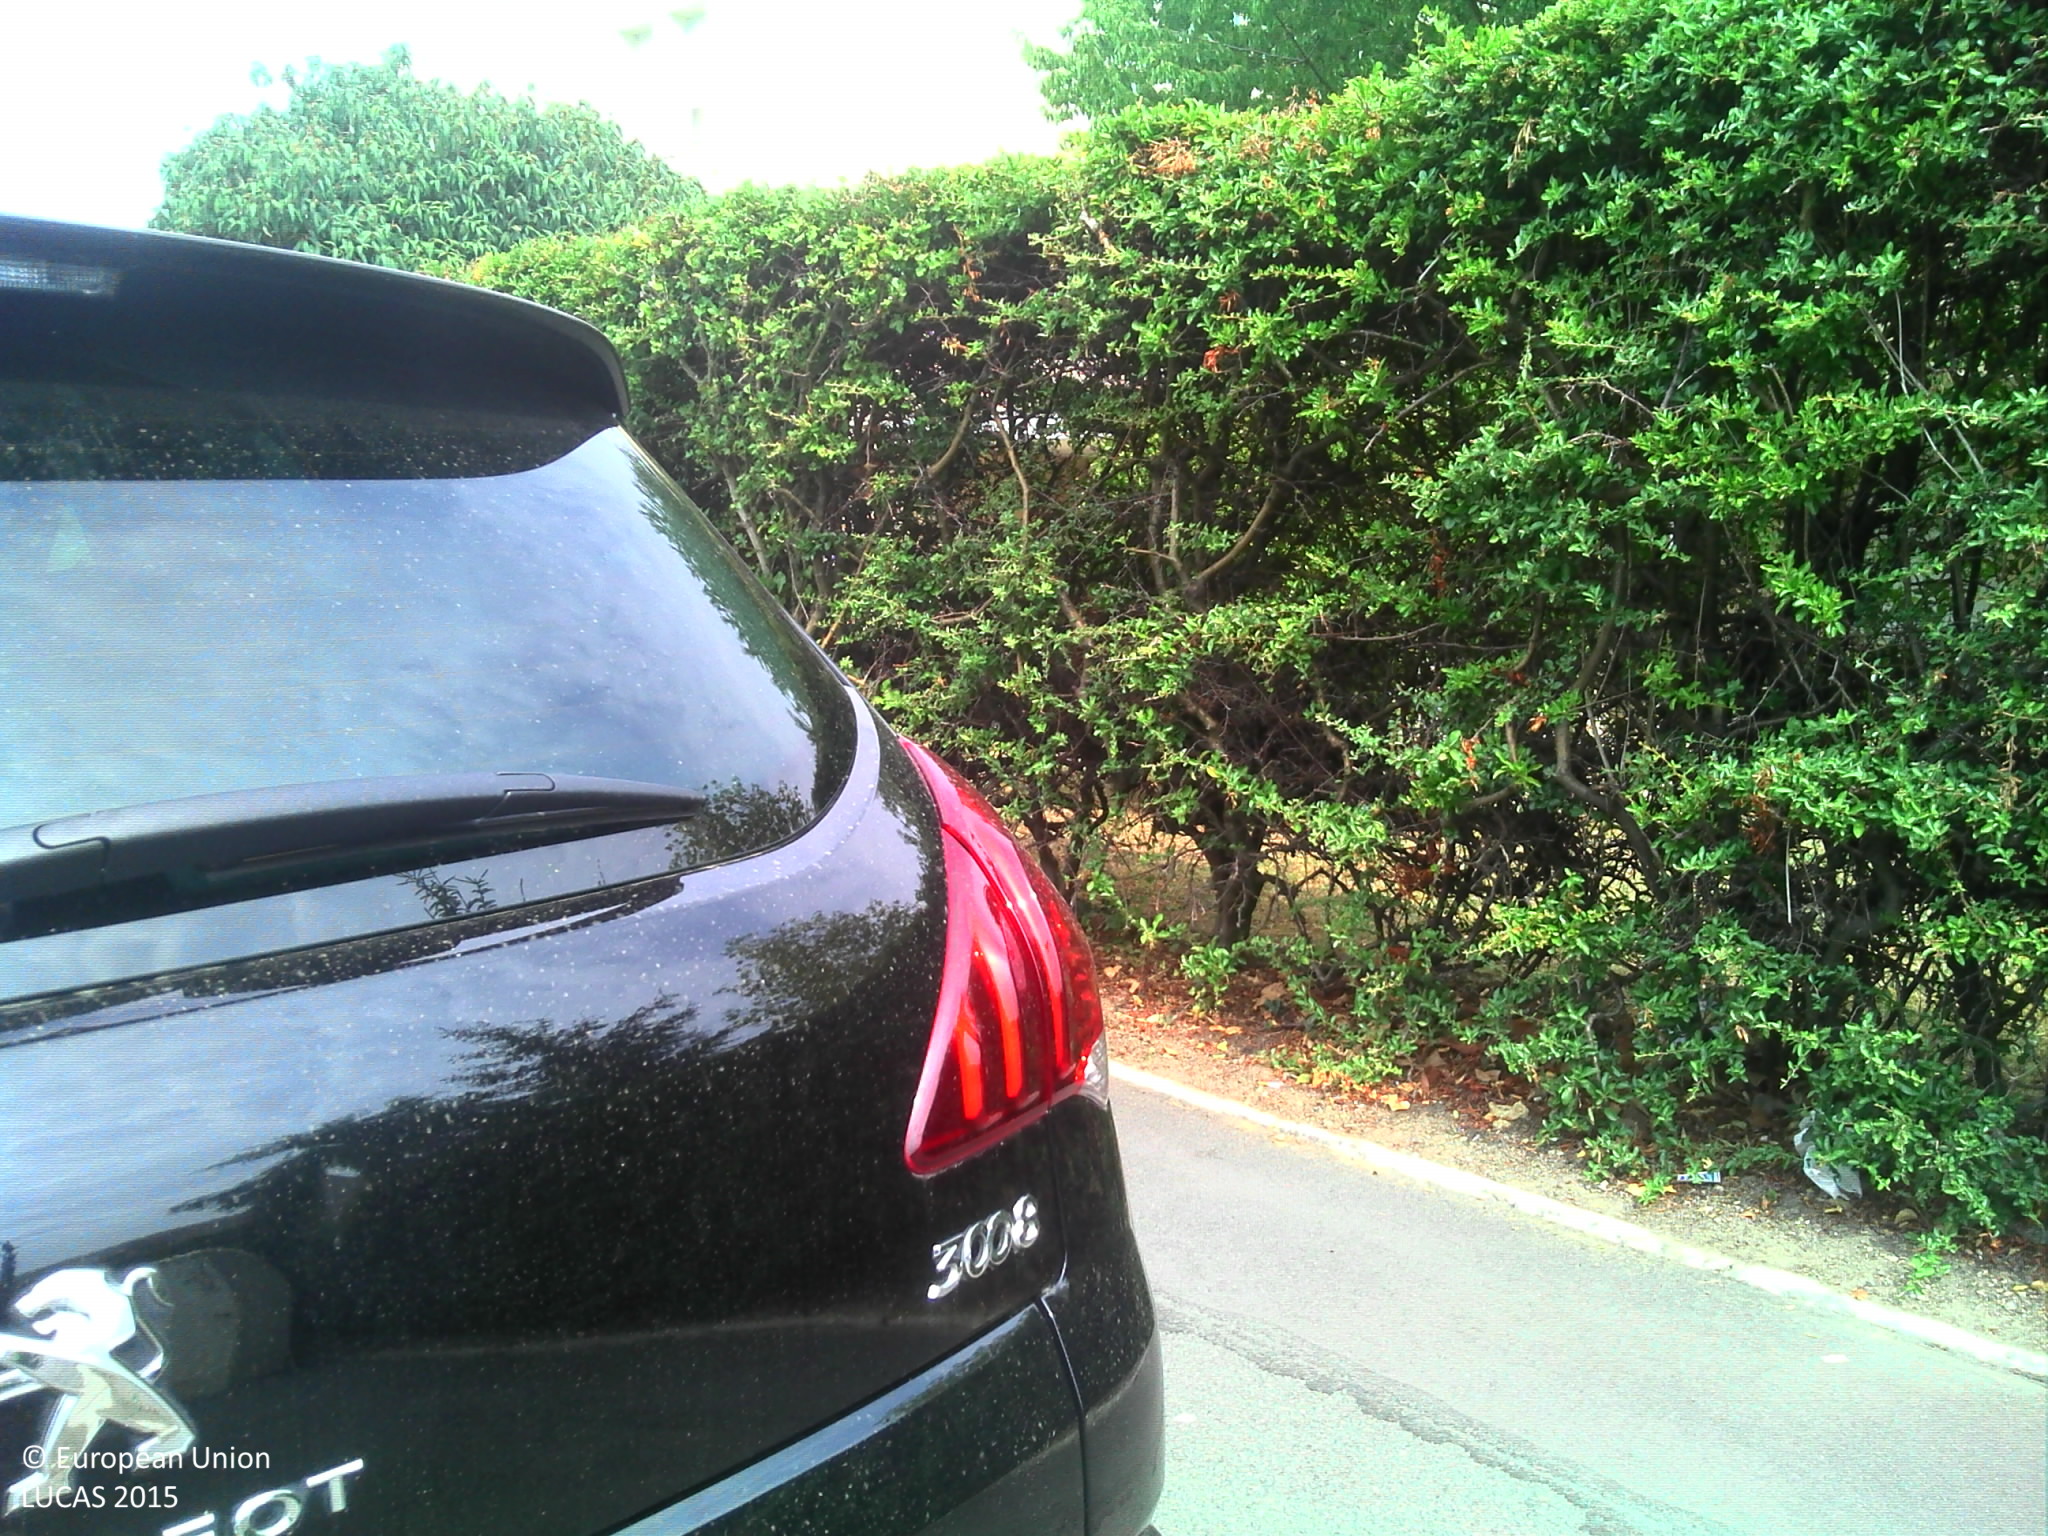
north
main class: Grassland
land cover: Grassland with sparse tree/shrub cover
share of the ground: > 75 %
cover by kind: herbaceous plants 80 %, broadleaved forest trees 5 %
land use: Residential
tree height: < 5 m
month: August
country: FR
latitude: 49.0035
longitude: 2.3188
